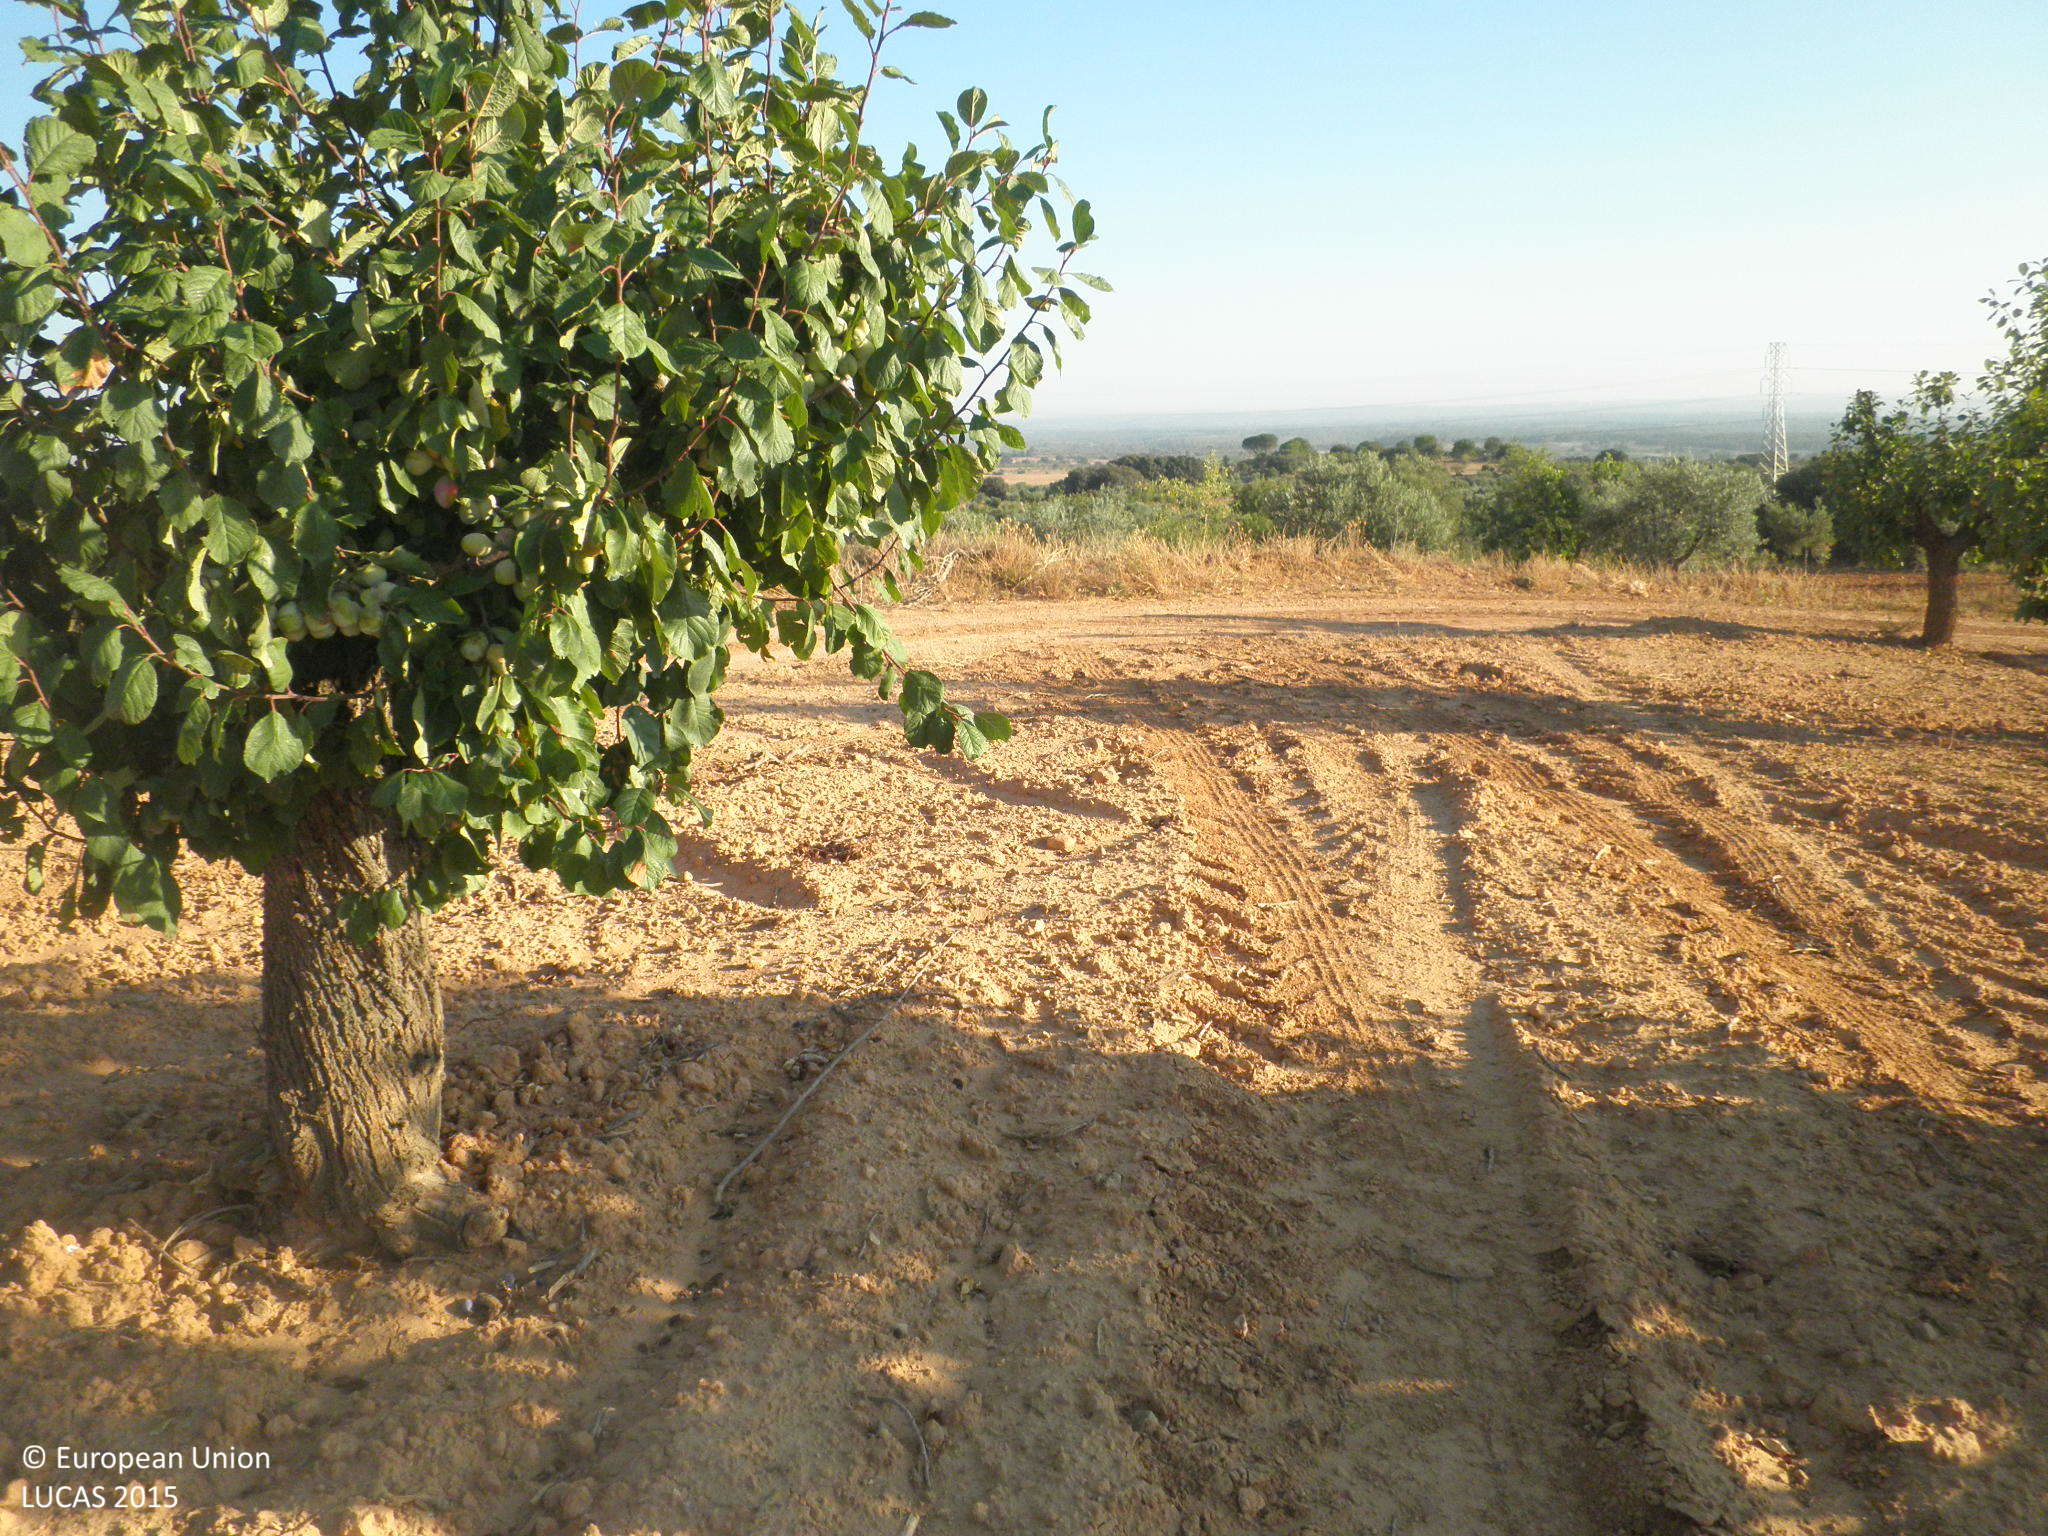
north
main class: Cropland
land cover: Other fruit trees and berries
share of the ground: 10 - 25 %
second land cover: Other bare soil
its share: > 75 %
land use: Agriculture (excluding fallow land and kitchen gardens)
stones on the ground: < 10 %
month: July
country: ES
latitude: 39.3786
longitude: -1.5771
